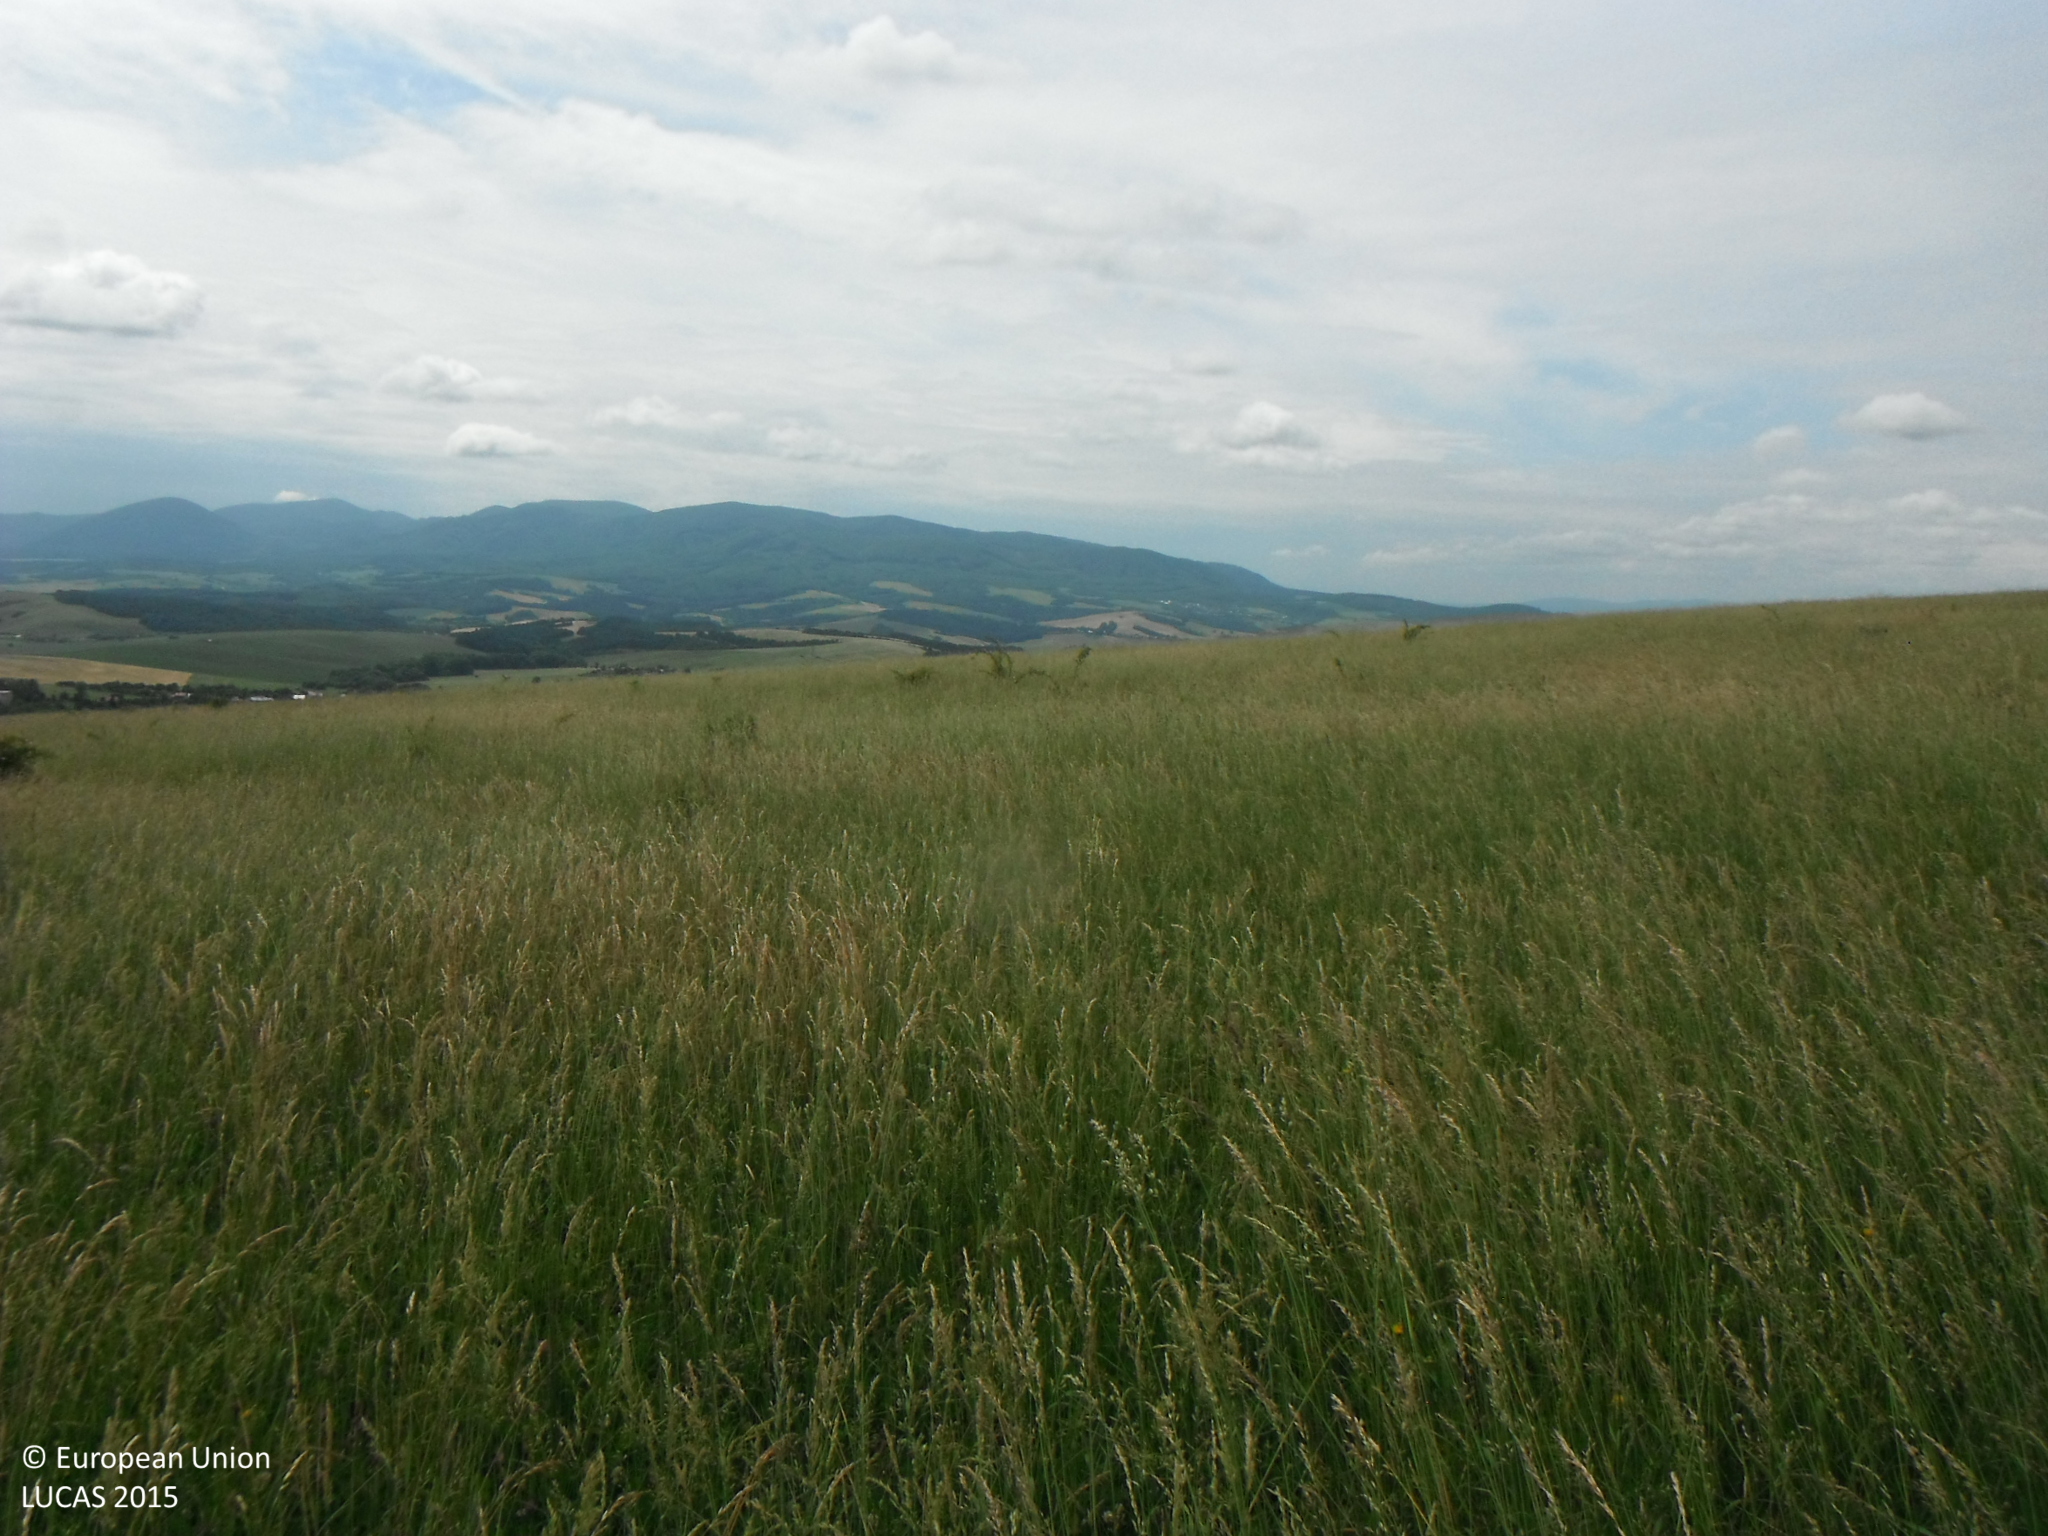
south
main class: Grassland
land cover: Grassland without tree/shrub cover
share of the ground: > 75 %
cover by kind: herbaceous plants 100 %
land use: Agriculture (excluding fallow land and kitchen gardens)
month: June
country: SK
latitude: 49.1015
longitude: 21.4020
